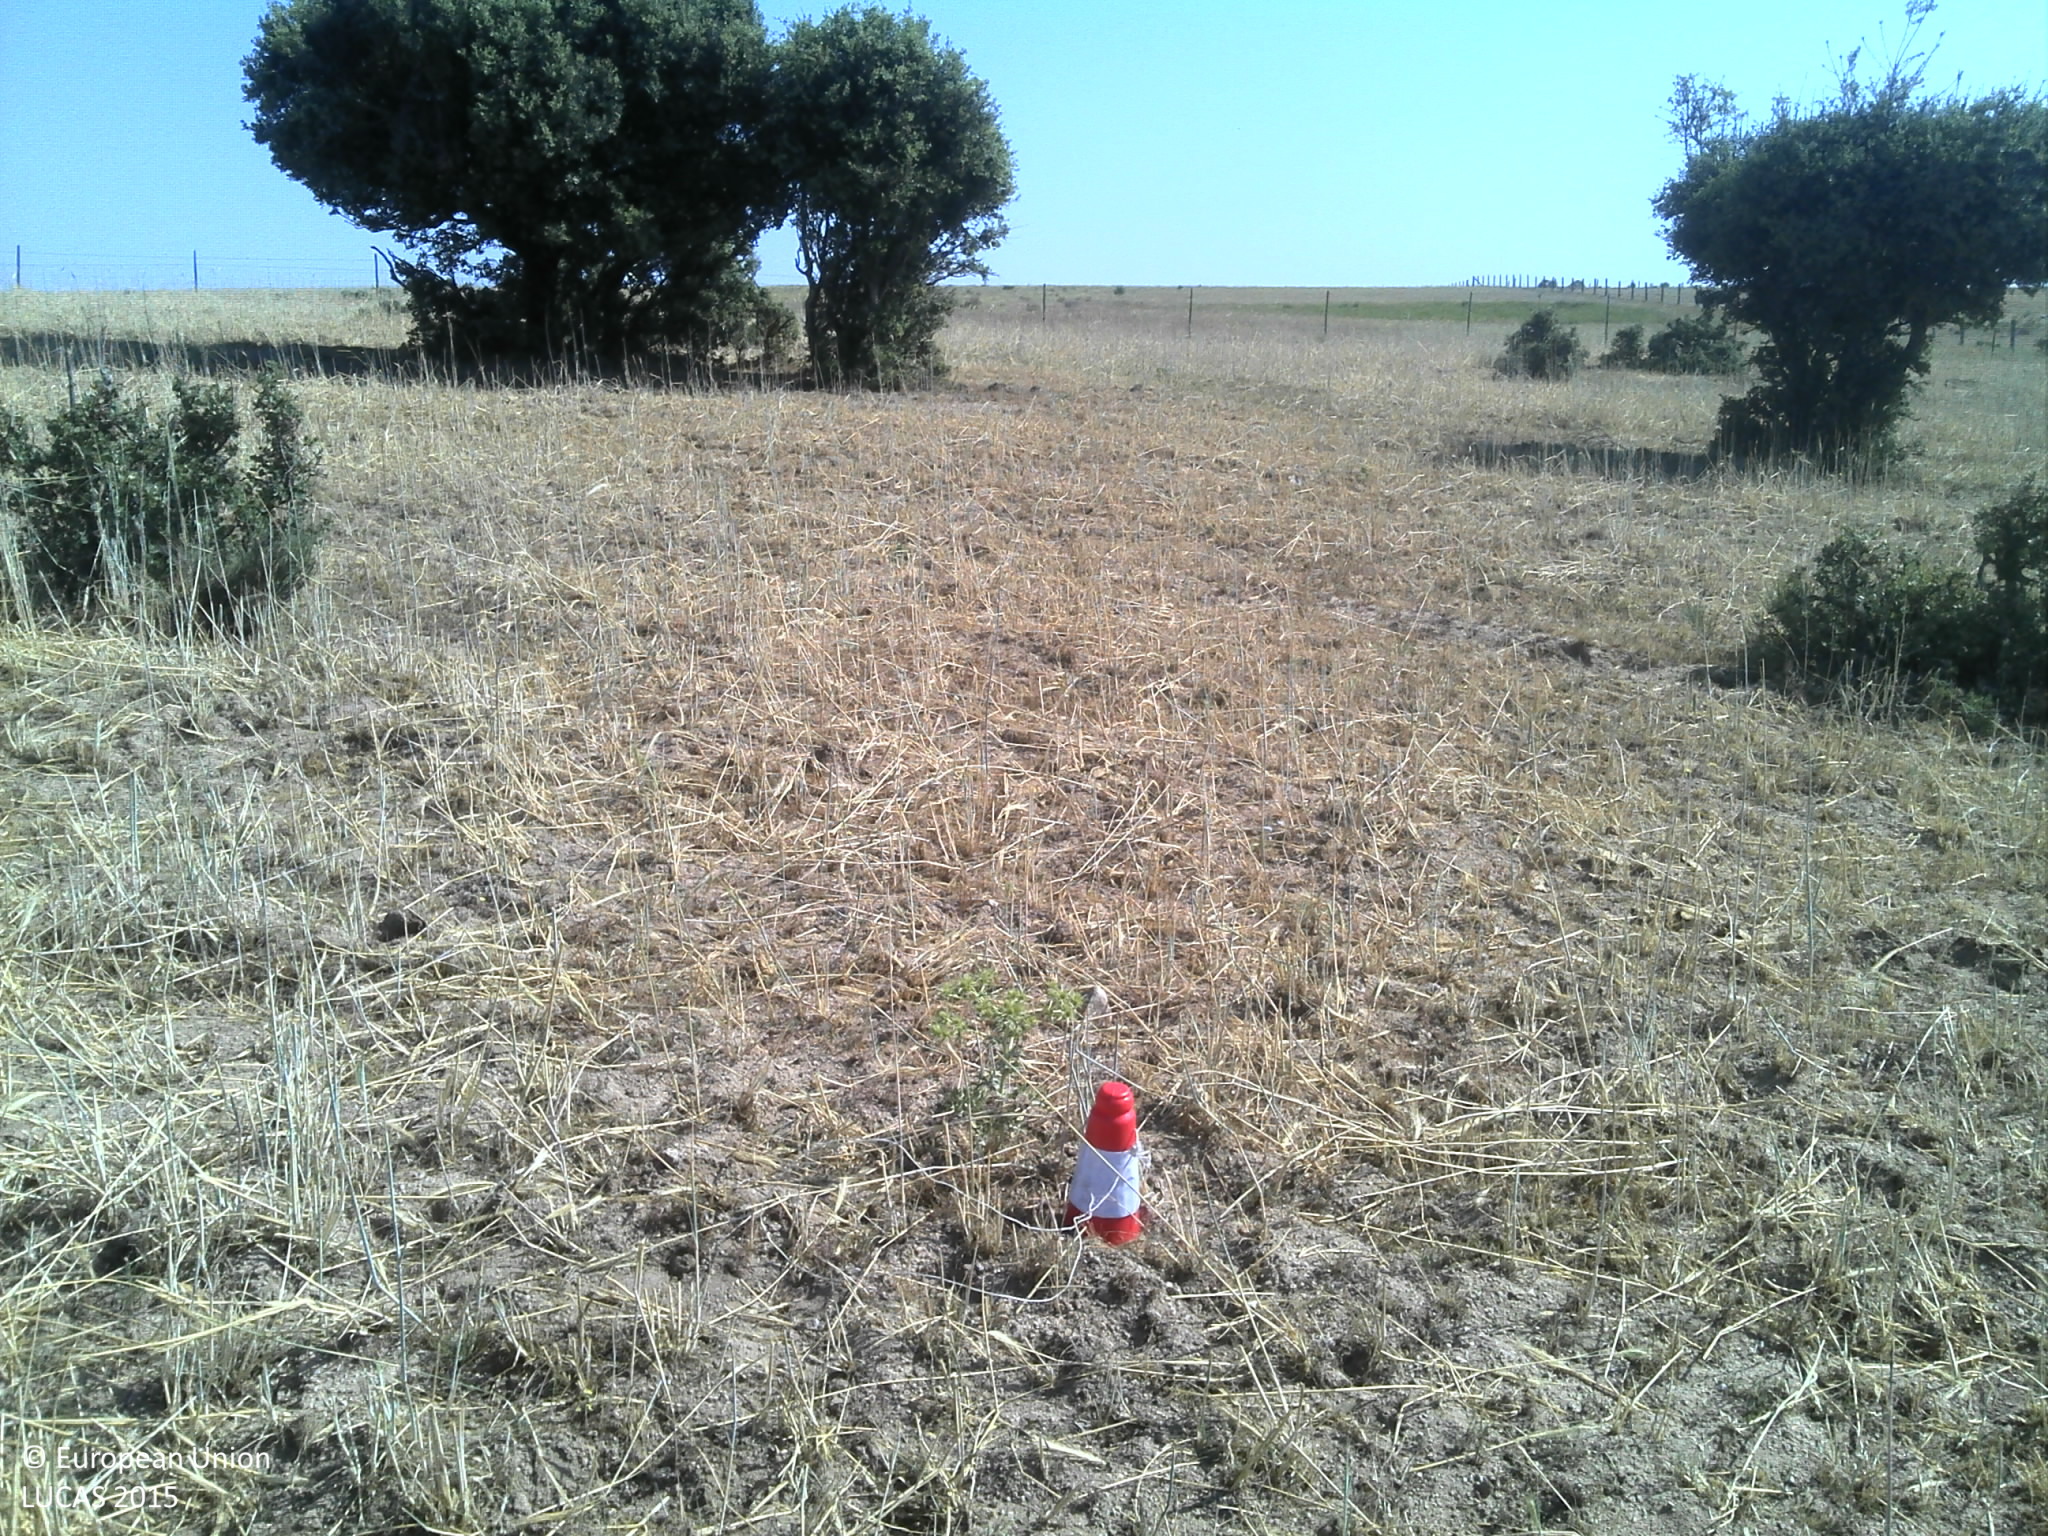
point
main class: Grassland
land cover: Grassland with sparse tree/shrub cover
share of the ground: 10 - 25 %
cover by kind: unconsolidated bare surface 85 %, herbaceous plants 10 %, broadleaved forest trees 5 %
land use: Agriculture (excluding fallow land and kitchen gardens)
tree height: > 5 m
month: June
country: PT
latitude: 40.5662
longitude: -6.8569
